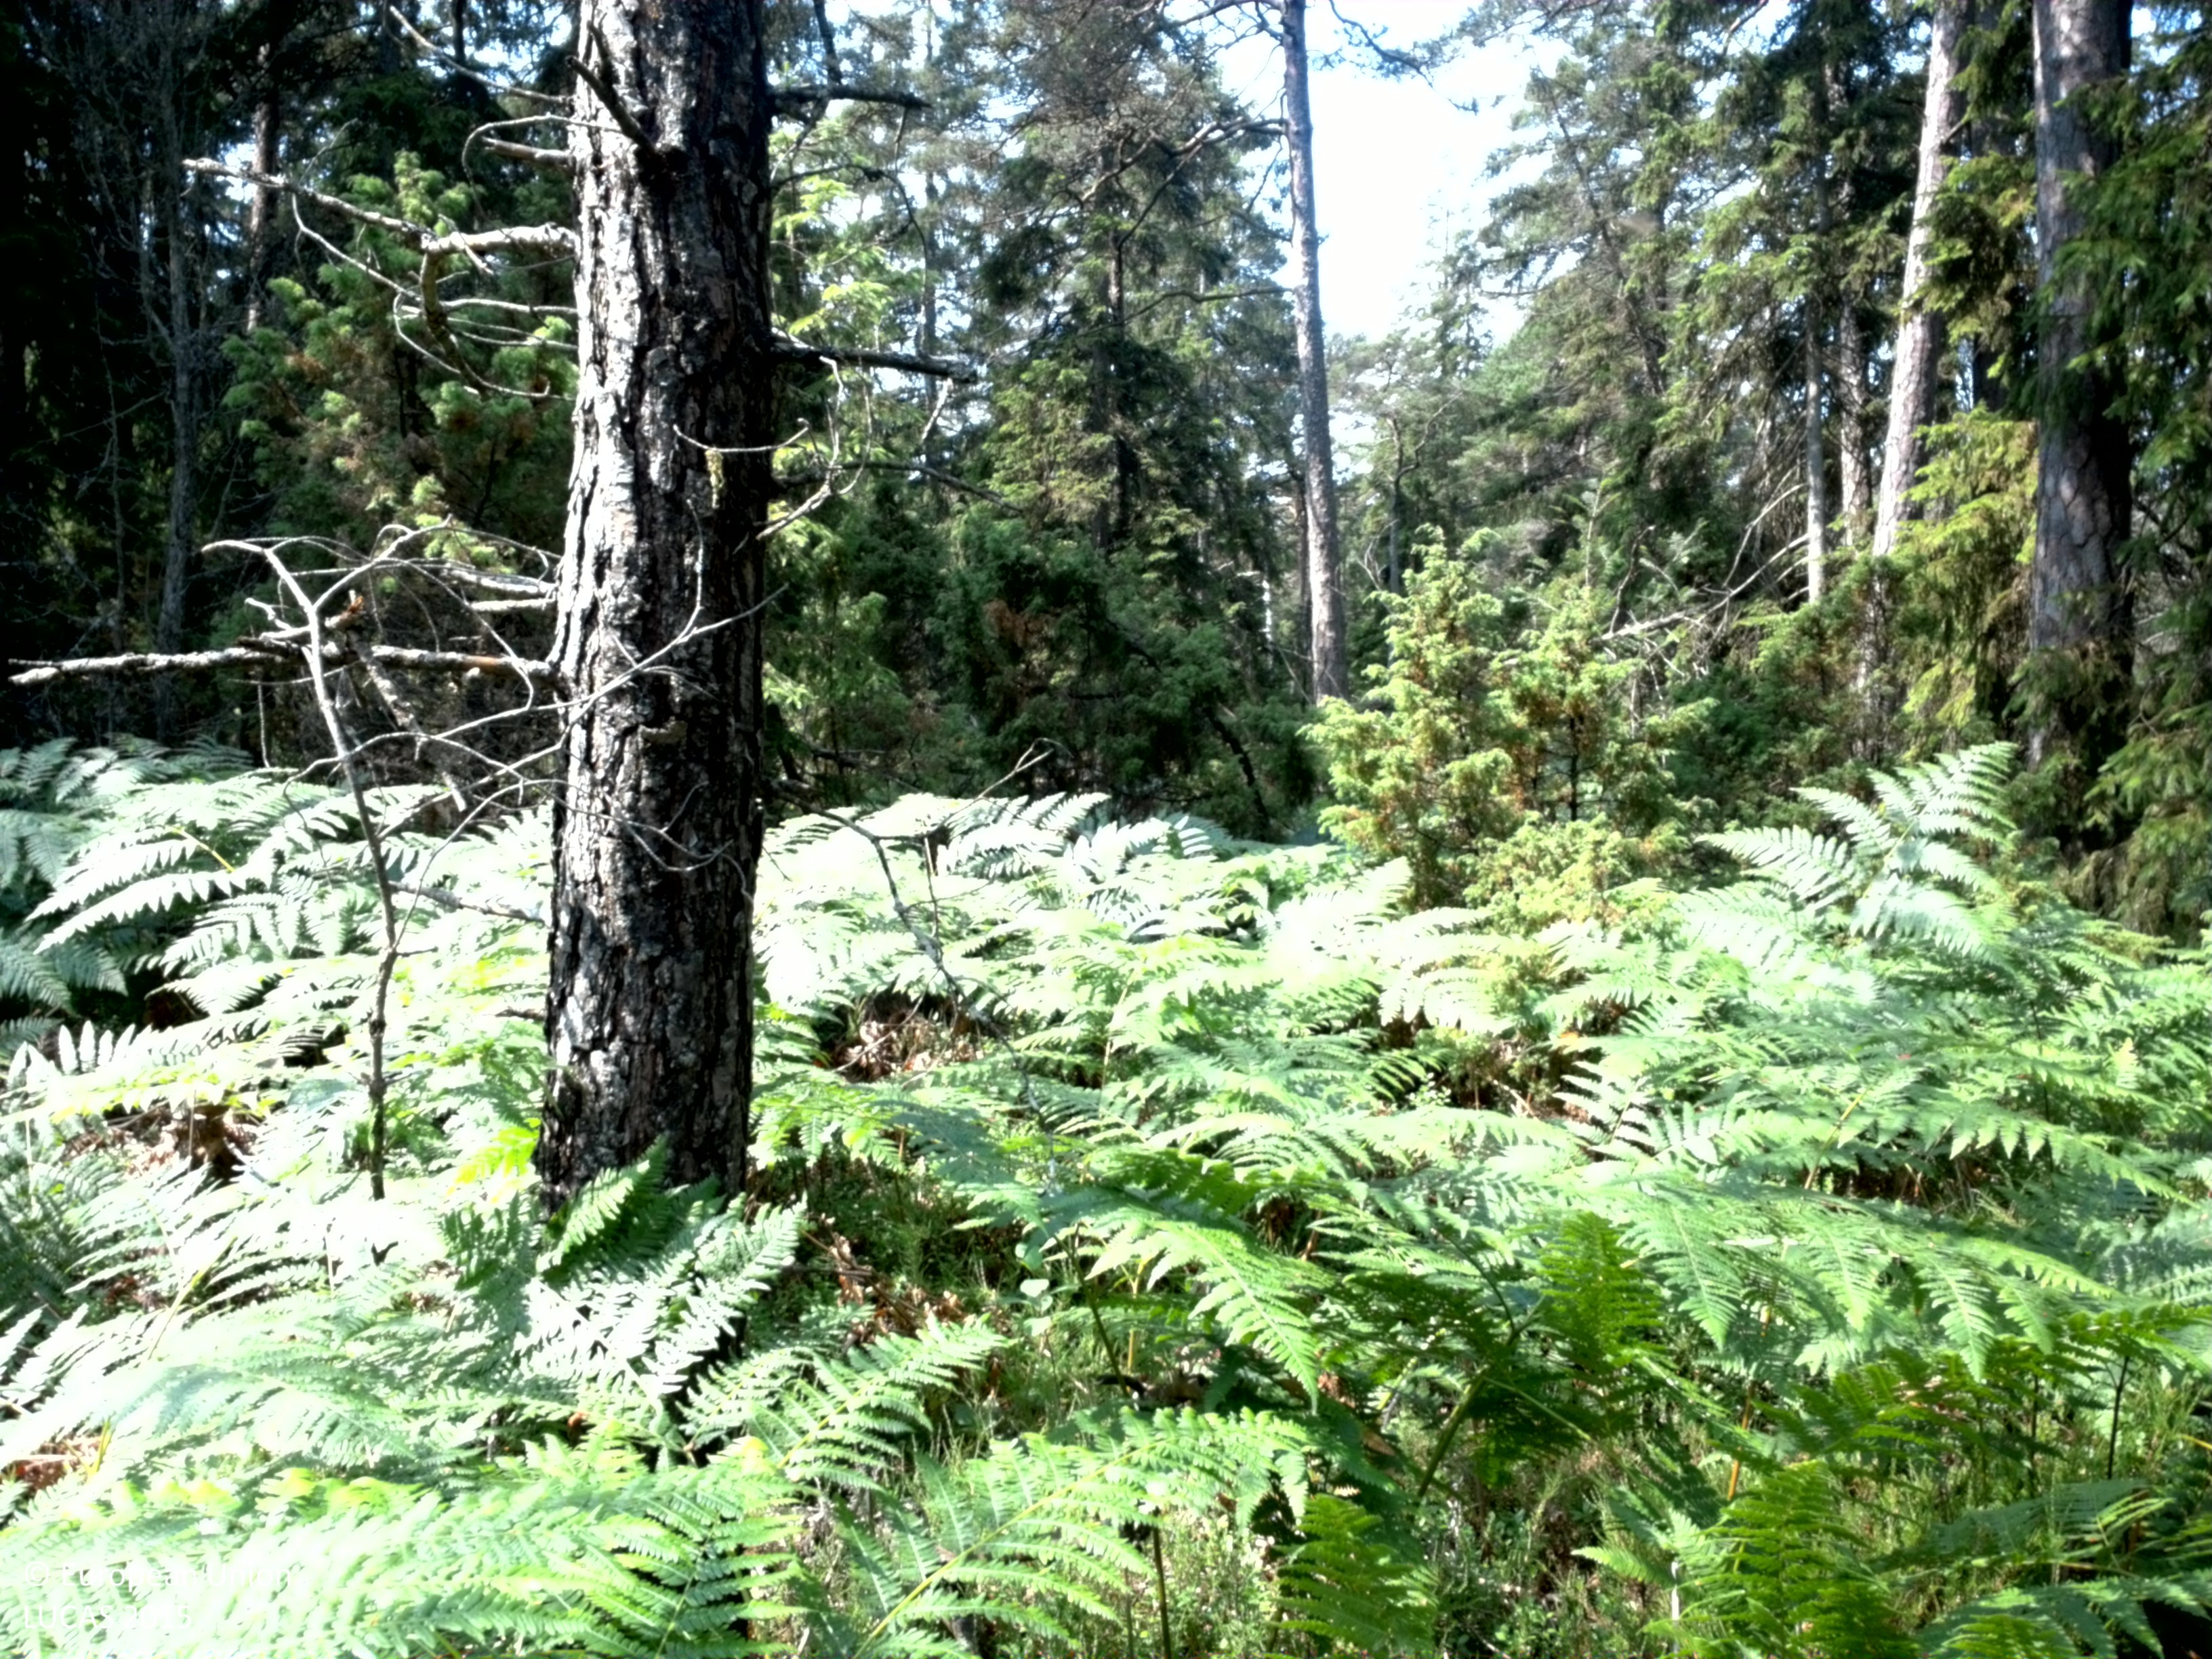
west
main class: Woodland
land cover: Pine dominated coniferous woodland
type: hemiboreal forest and nemoral coniferous forest and mixed broadleaved-coniferous forest
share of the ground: 50 - 75 %
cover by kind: coniferous forest trees 65 %, herbaceous plants 30 %, shrubs 5 %
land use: Forestry
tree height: > 5 m
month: July
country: SE
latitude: 57.3888
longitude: 18.7785
